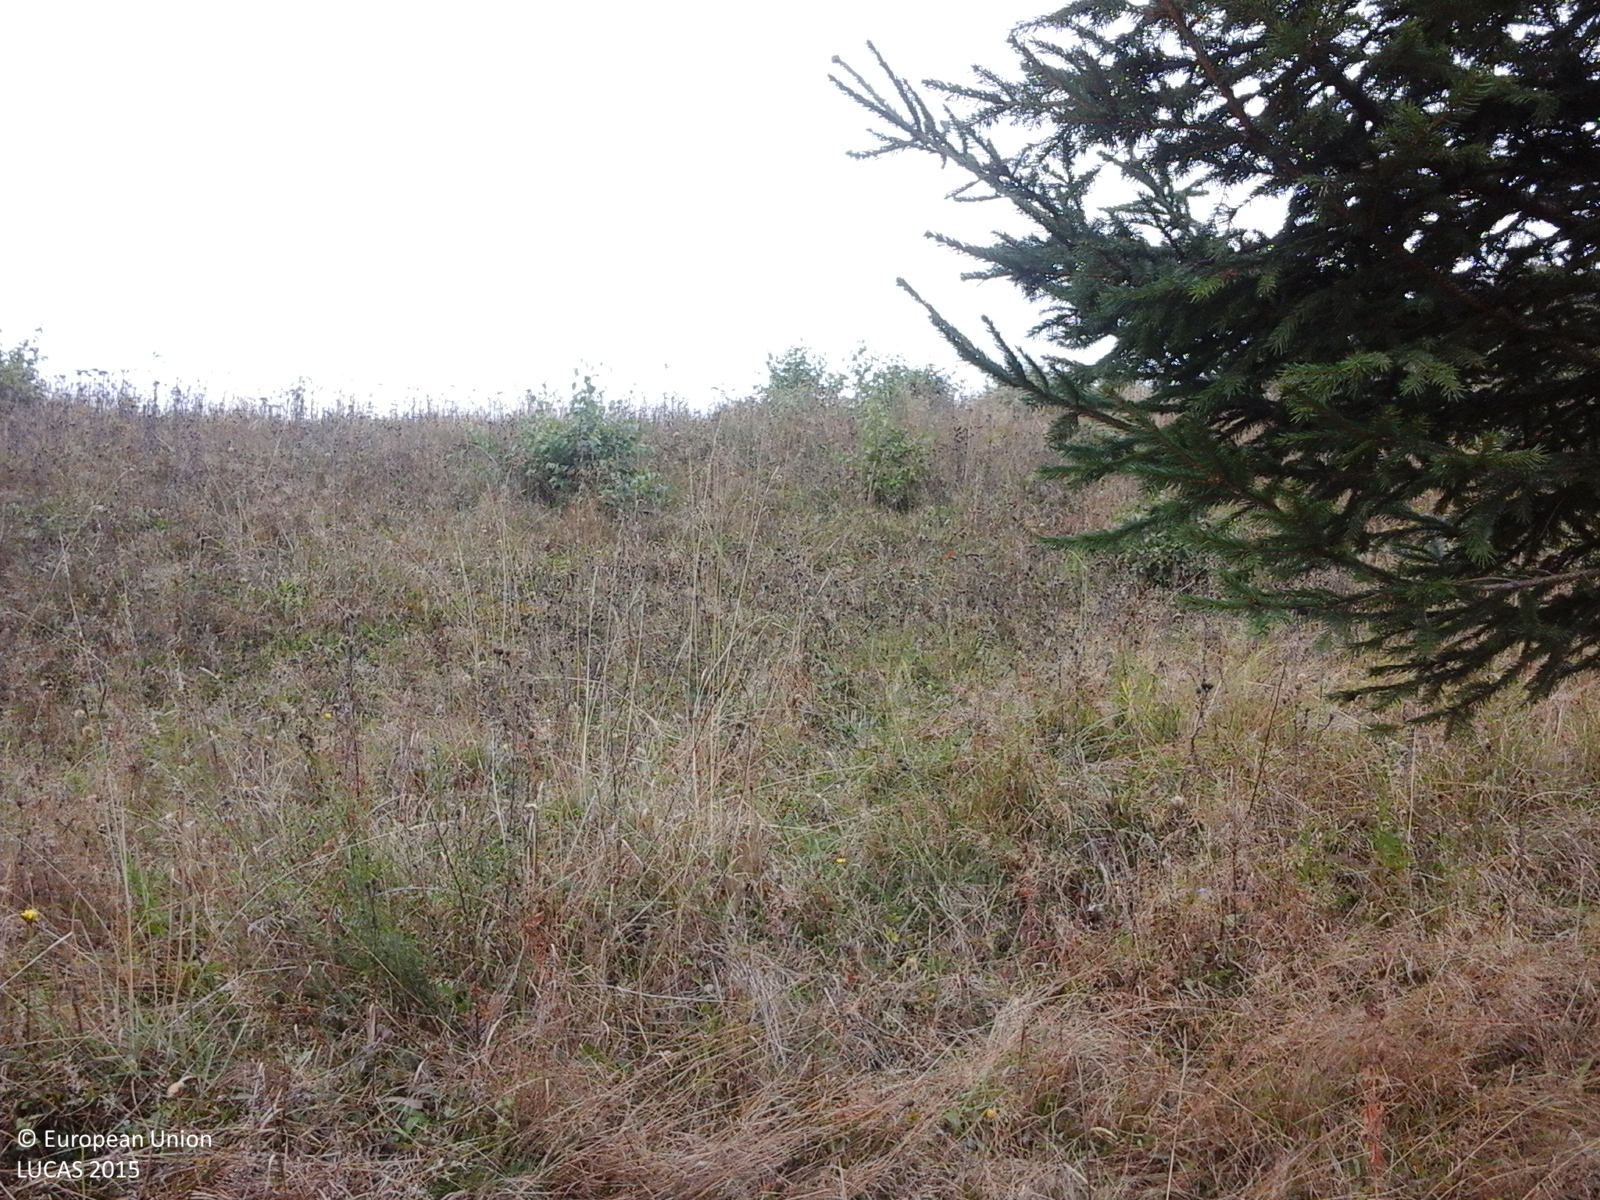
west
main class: Grassland
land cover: Spontaneously vegetated surfaces
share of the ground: > 75 %
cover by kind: herbaceous plants 100 %
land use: Forestry
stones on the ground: < 10 %
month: October
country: RO
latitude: 45.7360
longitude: 23.8586
